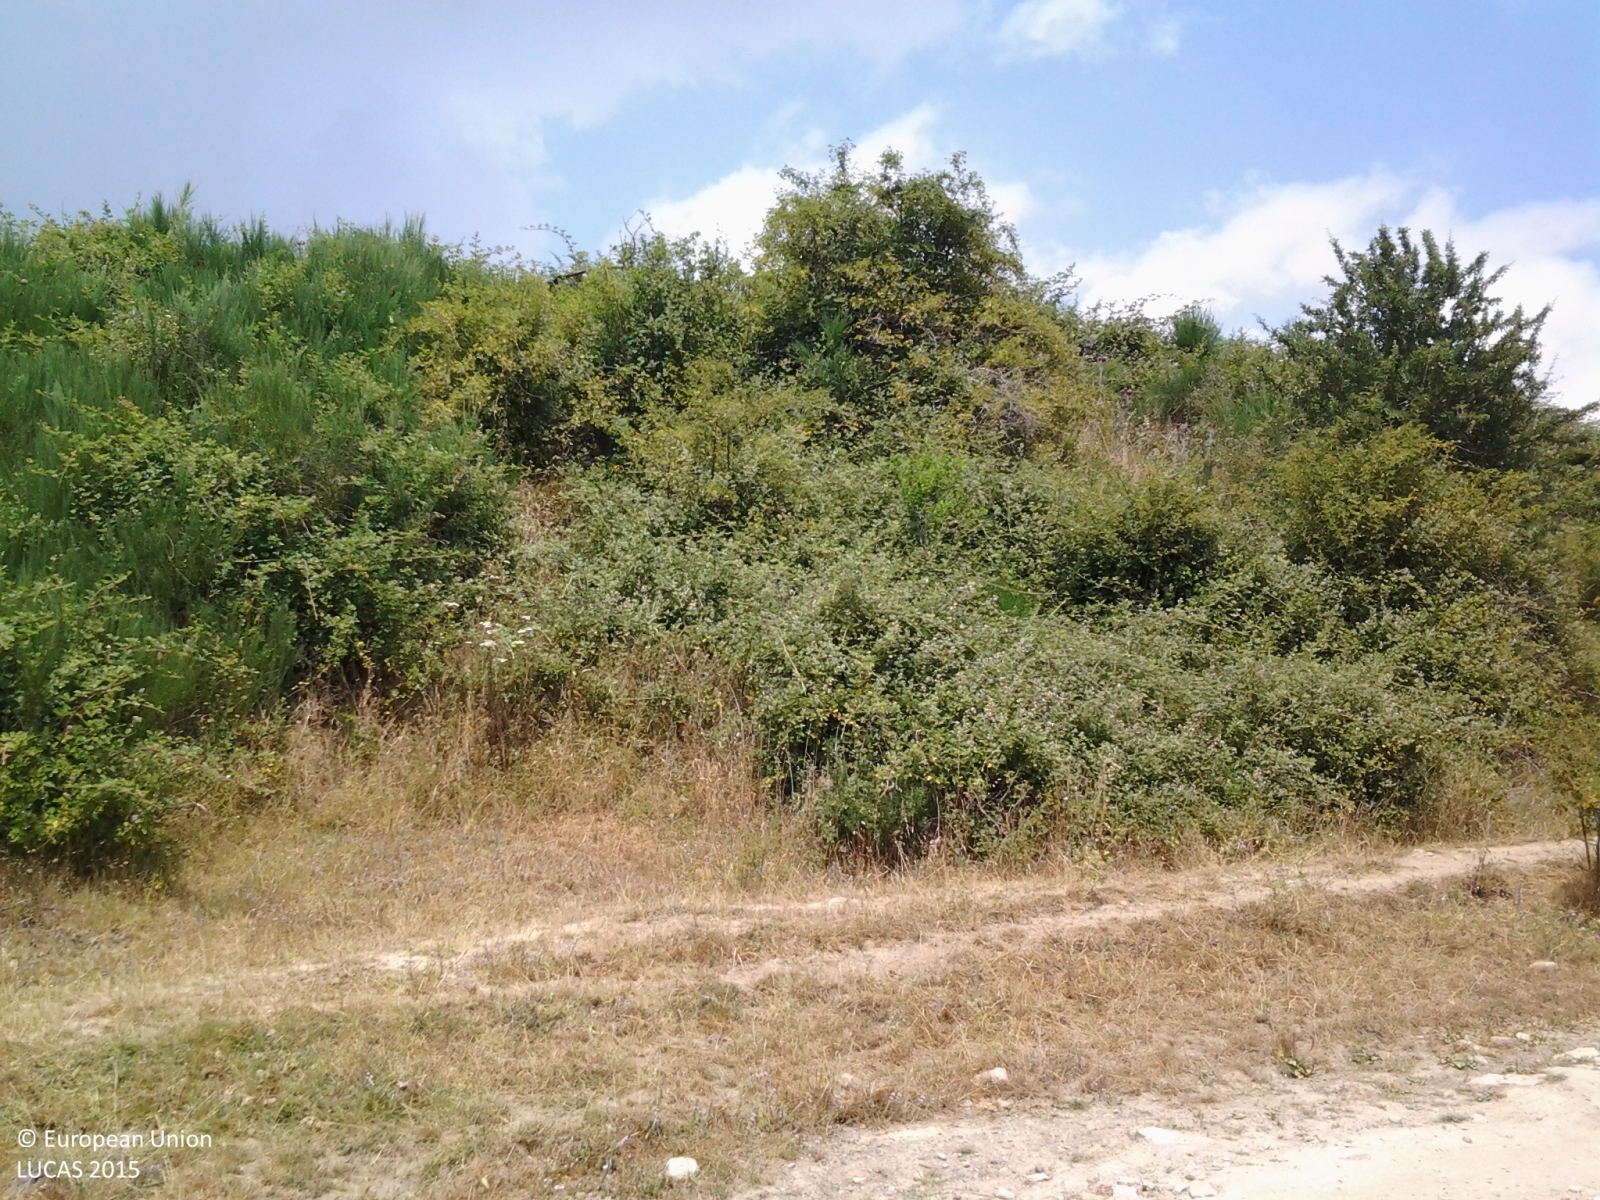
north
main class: Shrubland
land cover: Shrubland with sparse tree cover
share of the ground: > 75 %
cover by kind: shrubs 80 %, unconsolidated bare surface 10 %, broadleaved forest trees 5 %, herbaceous plants 5 %
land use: Agriculture (excluding fallow land and kitchen gardens)
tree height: < 5 m
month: July
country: IT
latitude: 37.9668
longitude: 14.8958
